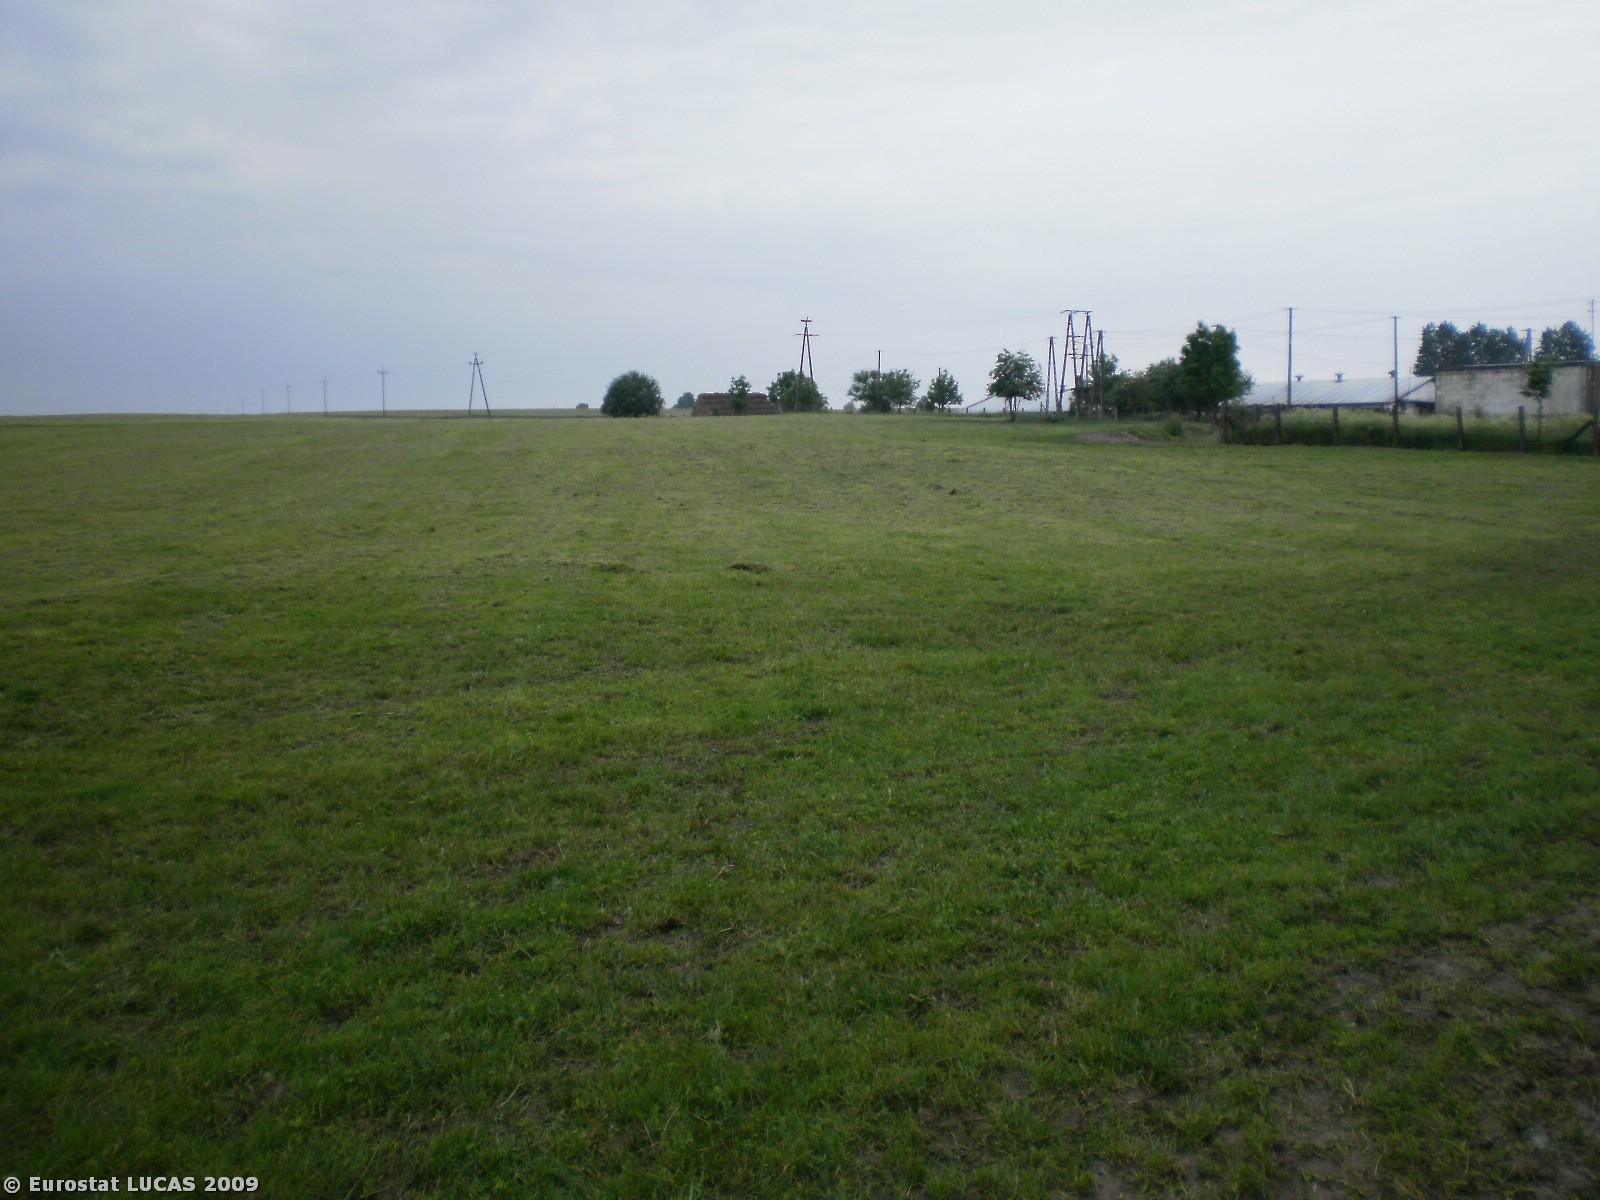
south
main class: Grassland
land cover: Grassland without tree/shrub cover
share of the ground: > 75 %
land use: Agriculture (excluding fallow land and kitchen gardens)
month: June
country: PL
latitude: 53.5984
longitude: 19.8366
